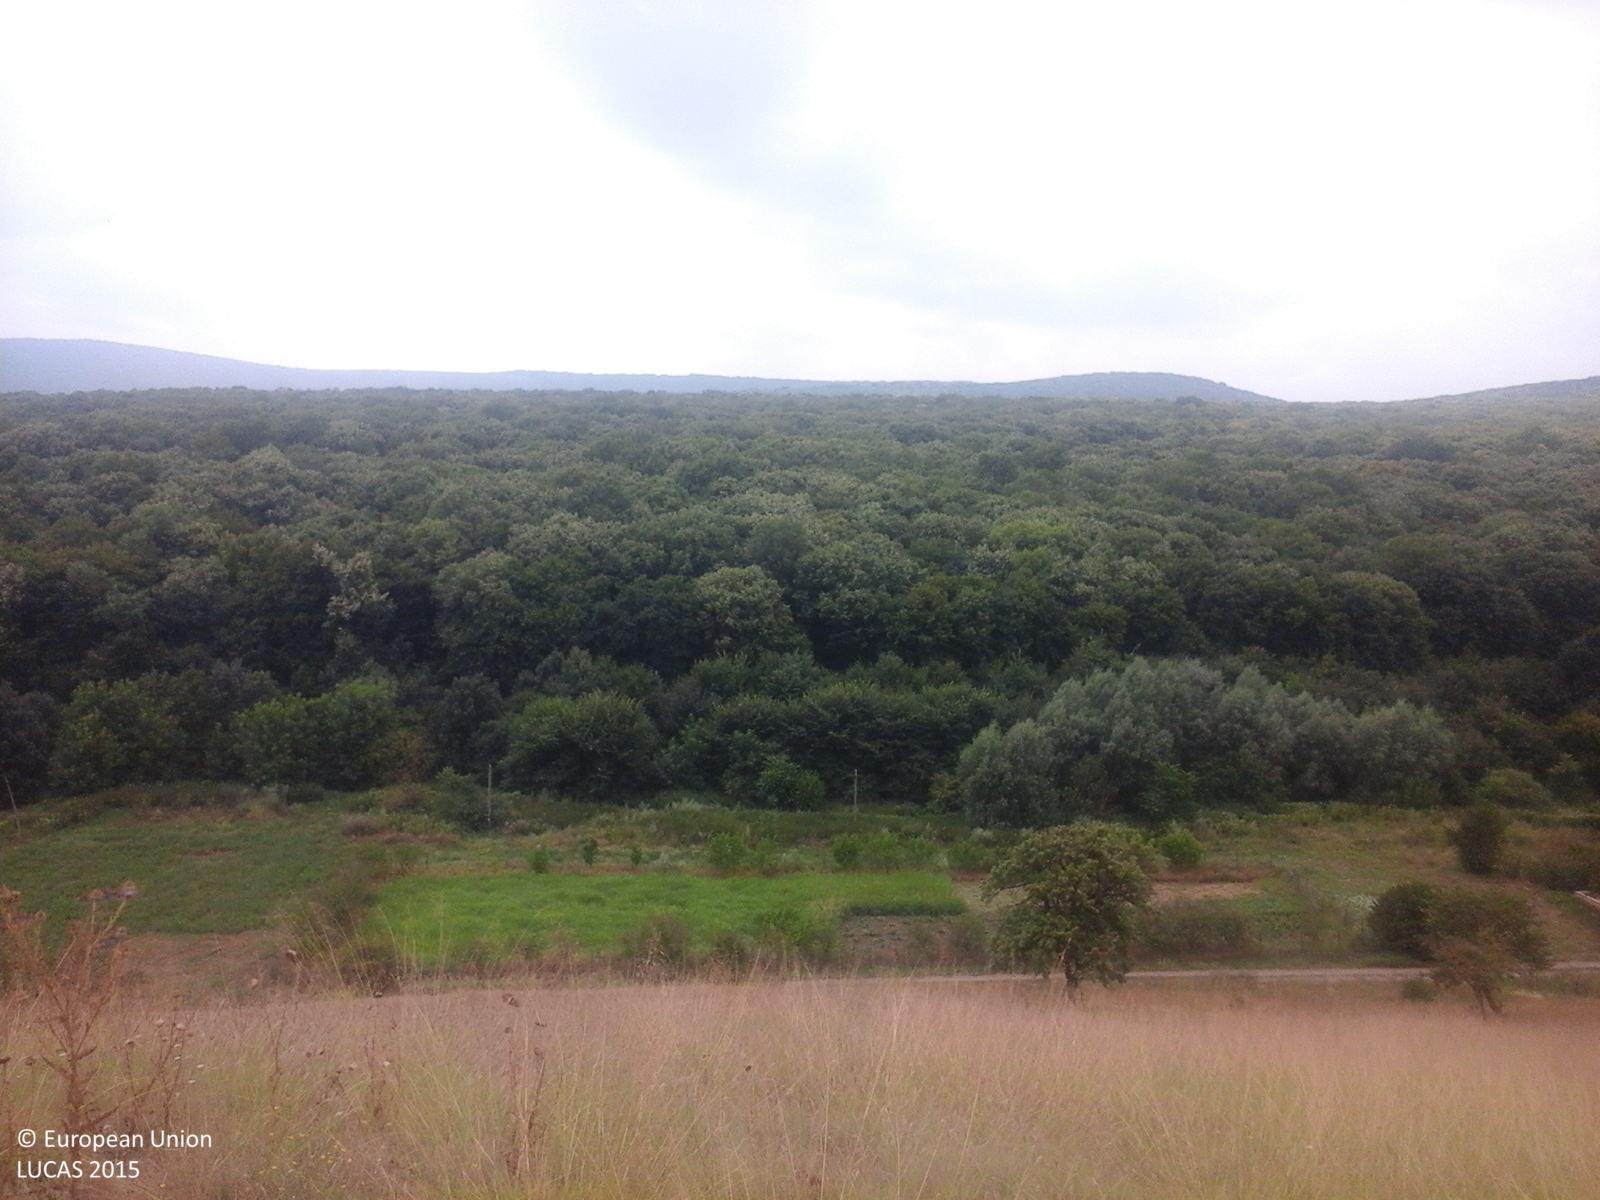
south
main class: Grassland
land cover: Grassland with sparse tree/shrub cover
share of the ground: > 75 %
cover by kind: herbaceous plants 85 %, shrubs 10 %, broadleaved forest trees 5 %
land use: Agriculture (excluding fallow land and kitchen gardens)
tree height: > 5 m
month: July
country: RO
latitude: 44.9335
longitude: 28.4360
